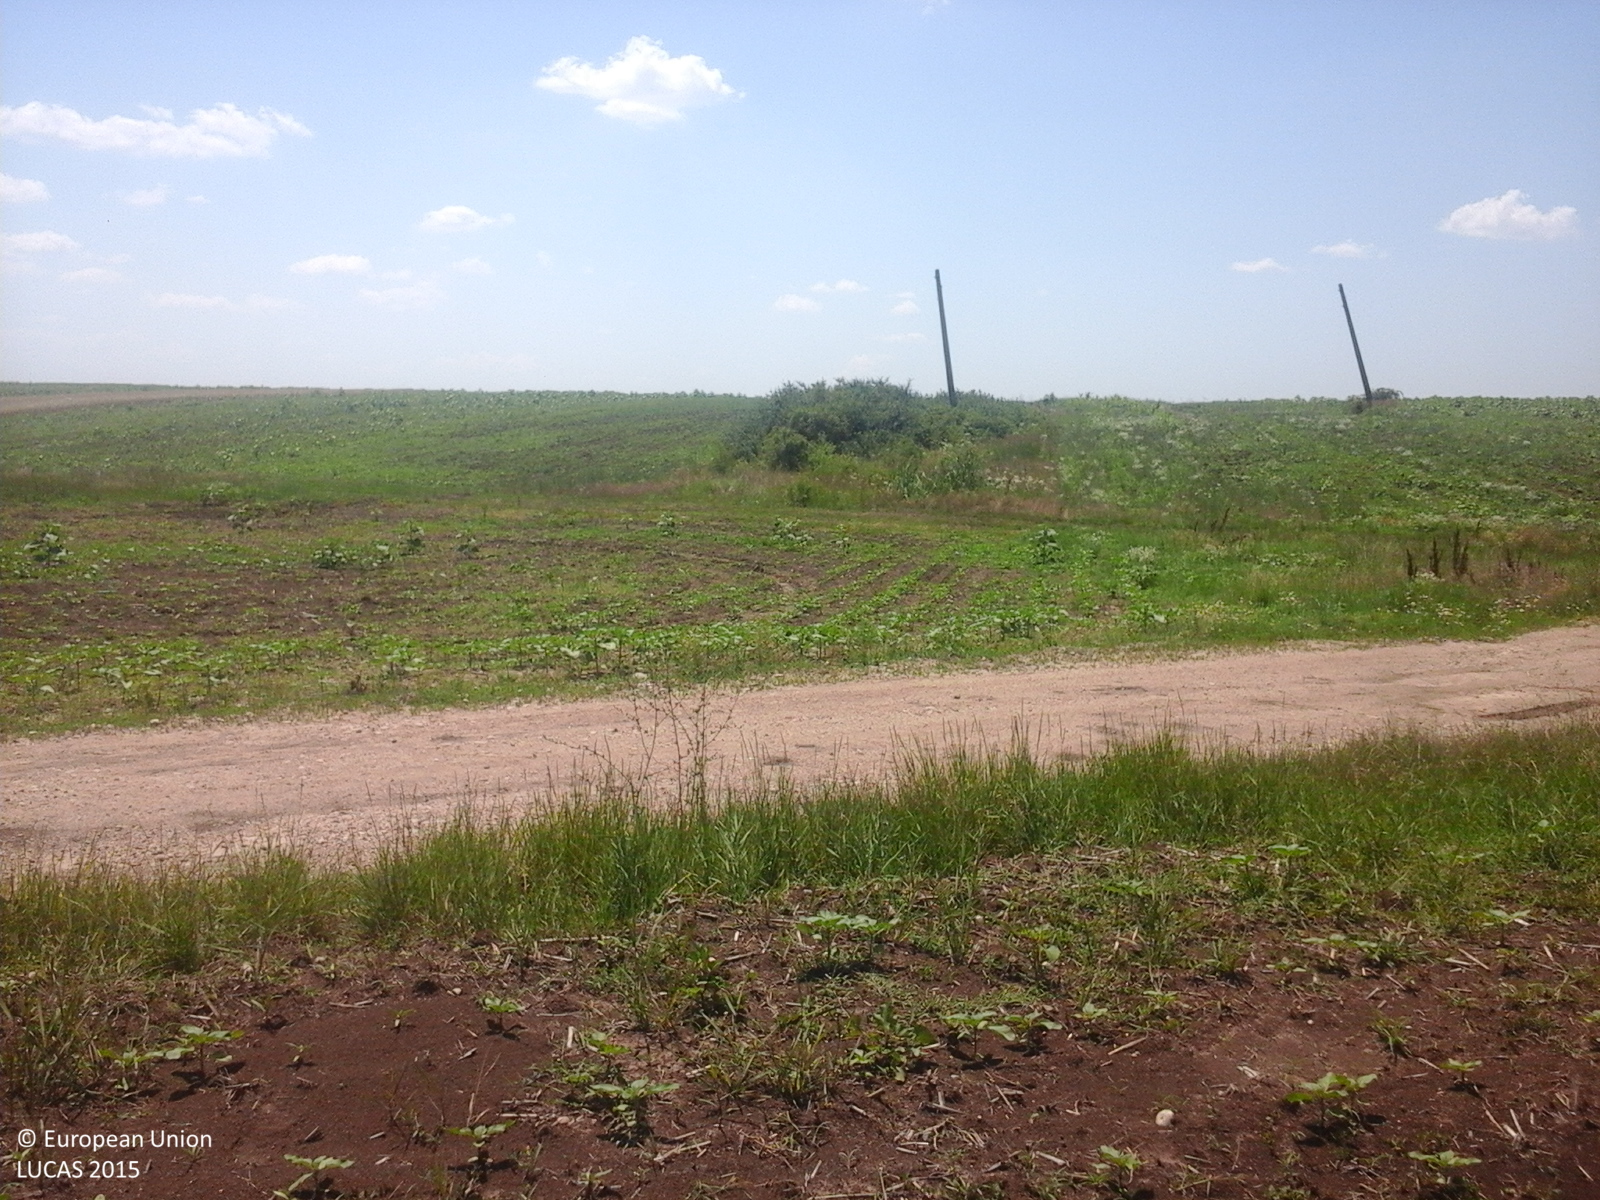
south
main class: Cropland
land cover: Sunflower
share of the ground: < 10 %
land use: Agriculture (excluding fallow land and kitchen gardens)
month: July
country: RO
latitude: 44.4342
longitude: 24.6847
